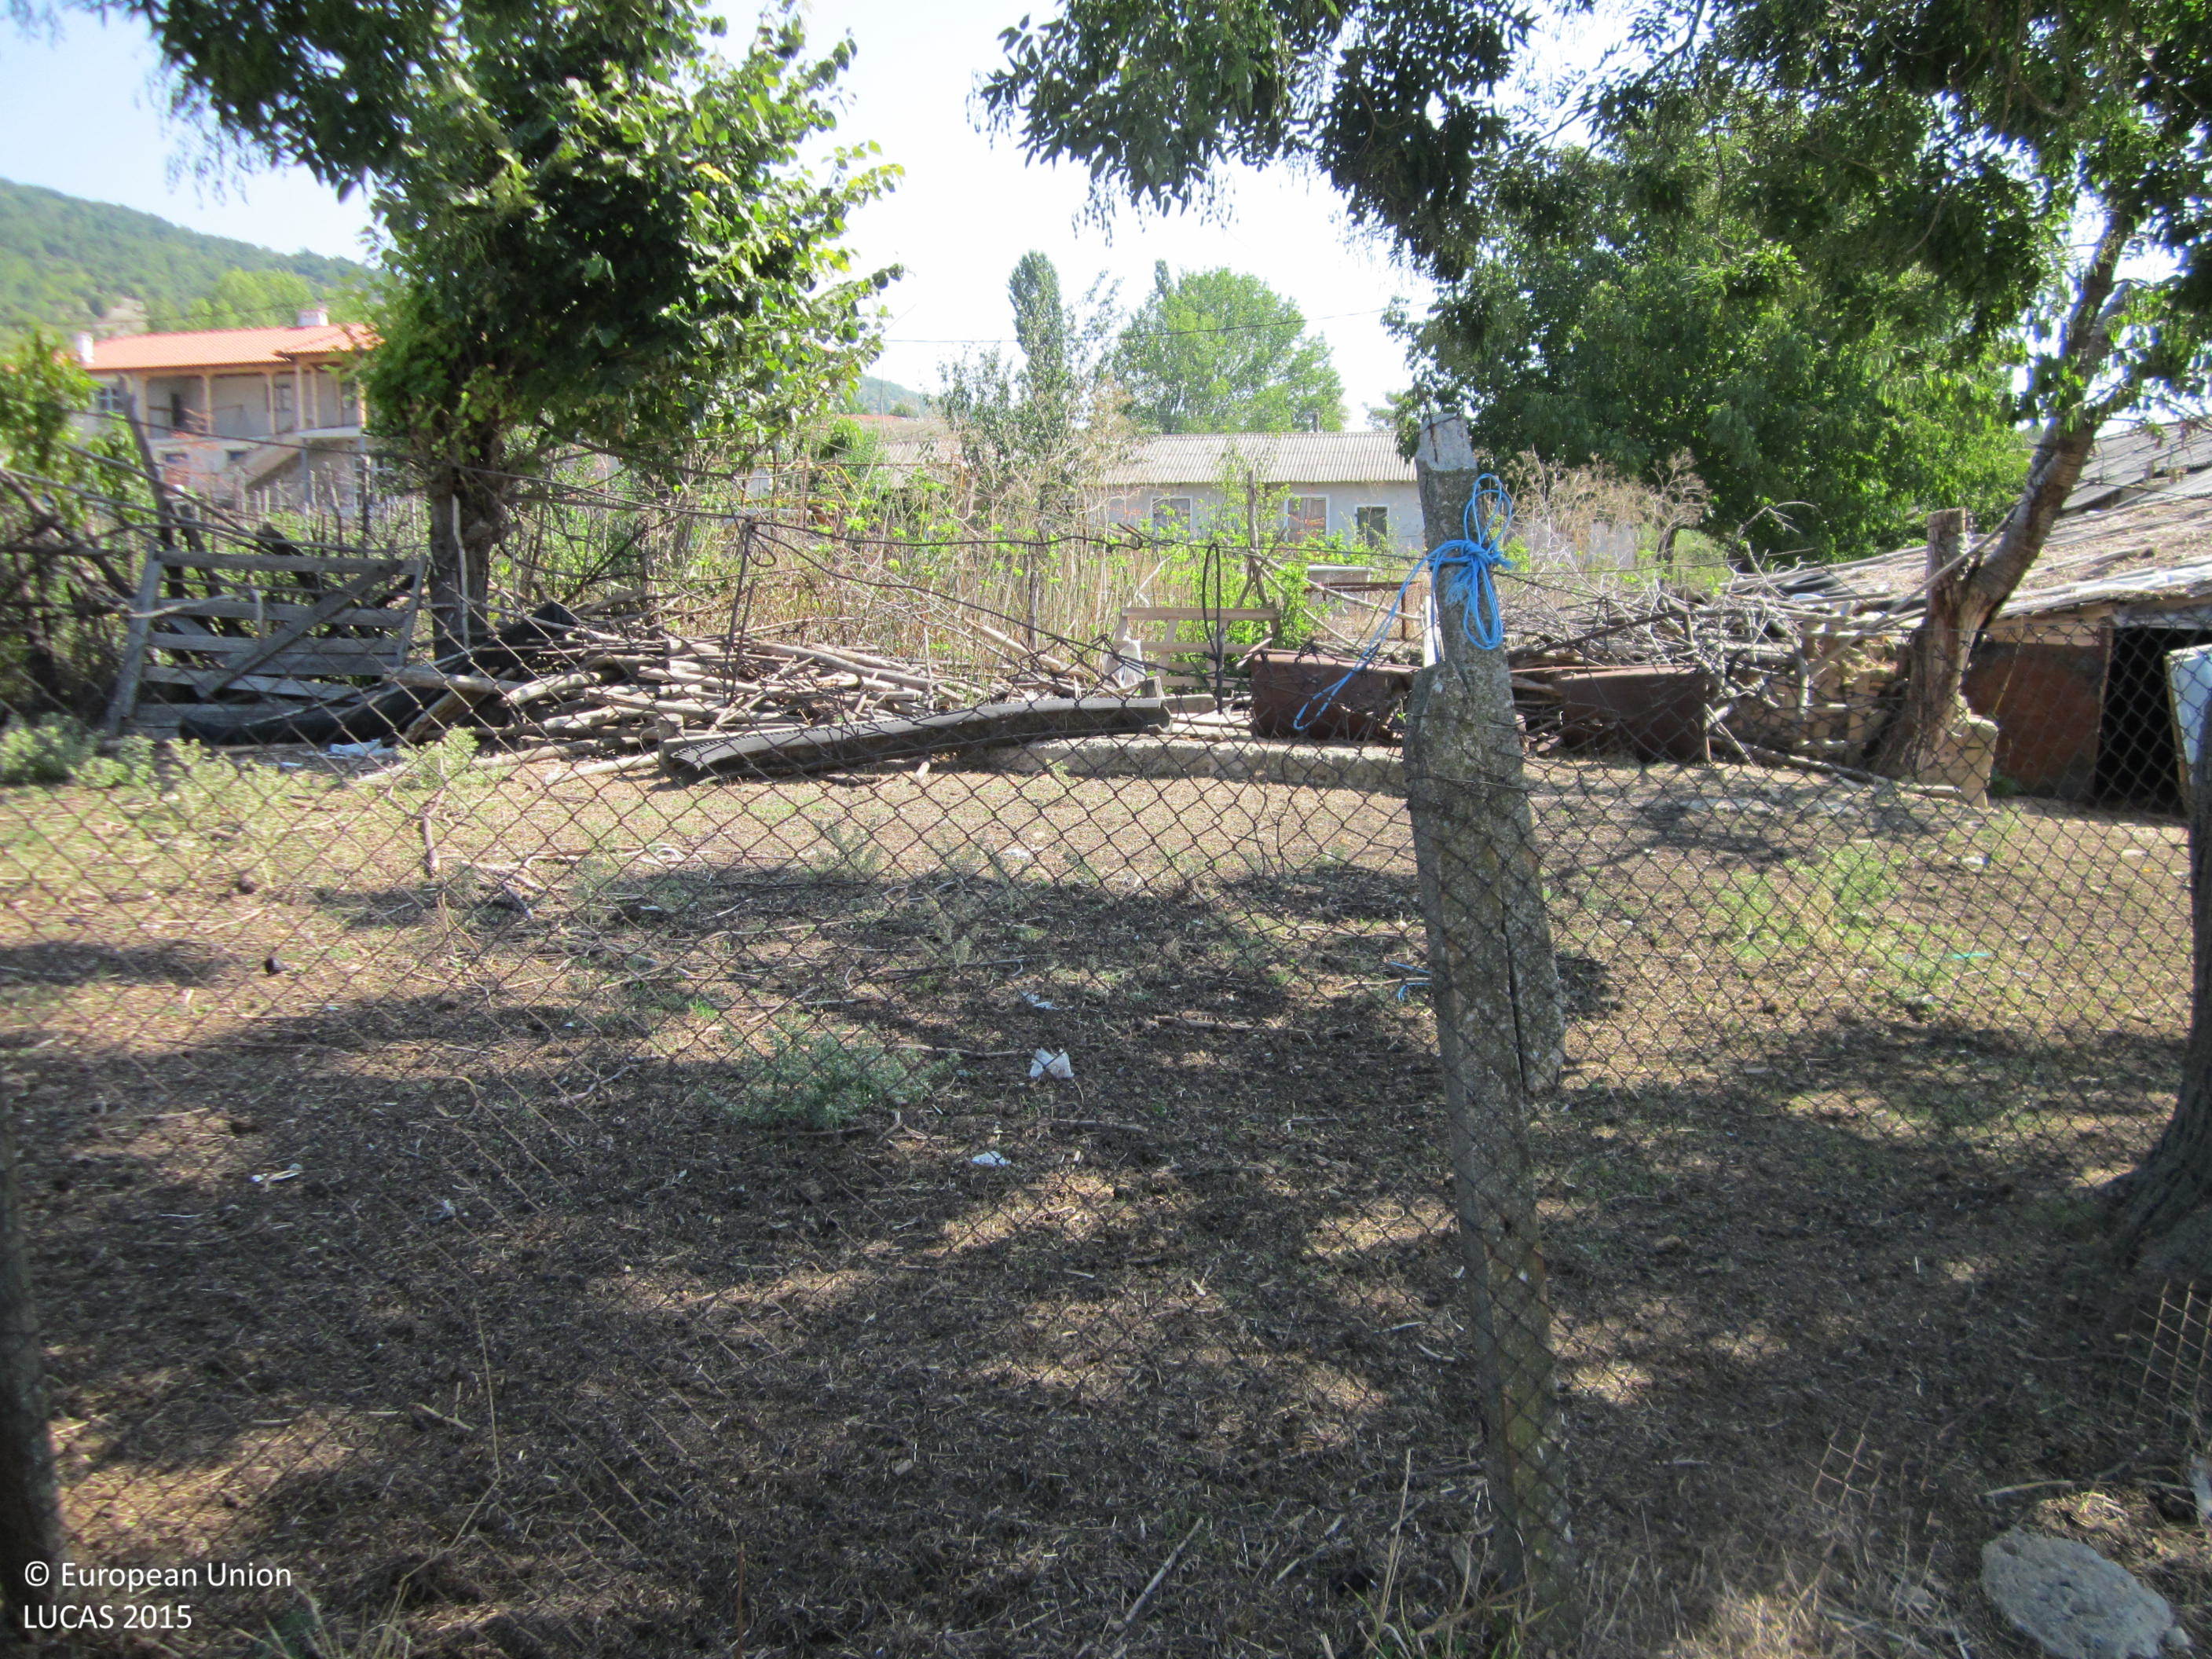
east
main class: Grassland
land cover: Grassland with sparse tree/shrub cover
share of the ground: > 75 %
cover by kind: herbaceous plants 80 %, unconsolidated bare surface 10 %, broadleaved forest trees 5 %, shrubs 5 %
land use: Residential
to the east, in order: Grassland with sparse tree/shrub cover; Artificial constructions in urban areas; Rivers and streams; Artificial constructions in urban areas; Grassland without tree/shrub cover; Tracks; Grassland without tree/shrub cover
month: September
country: BG
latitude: 42.8853
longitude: 26.9688
